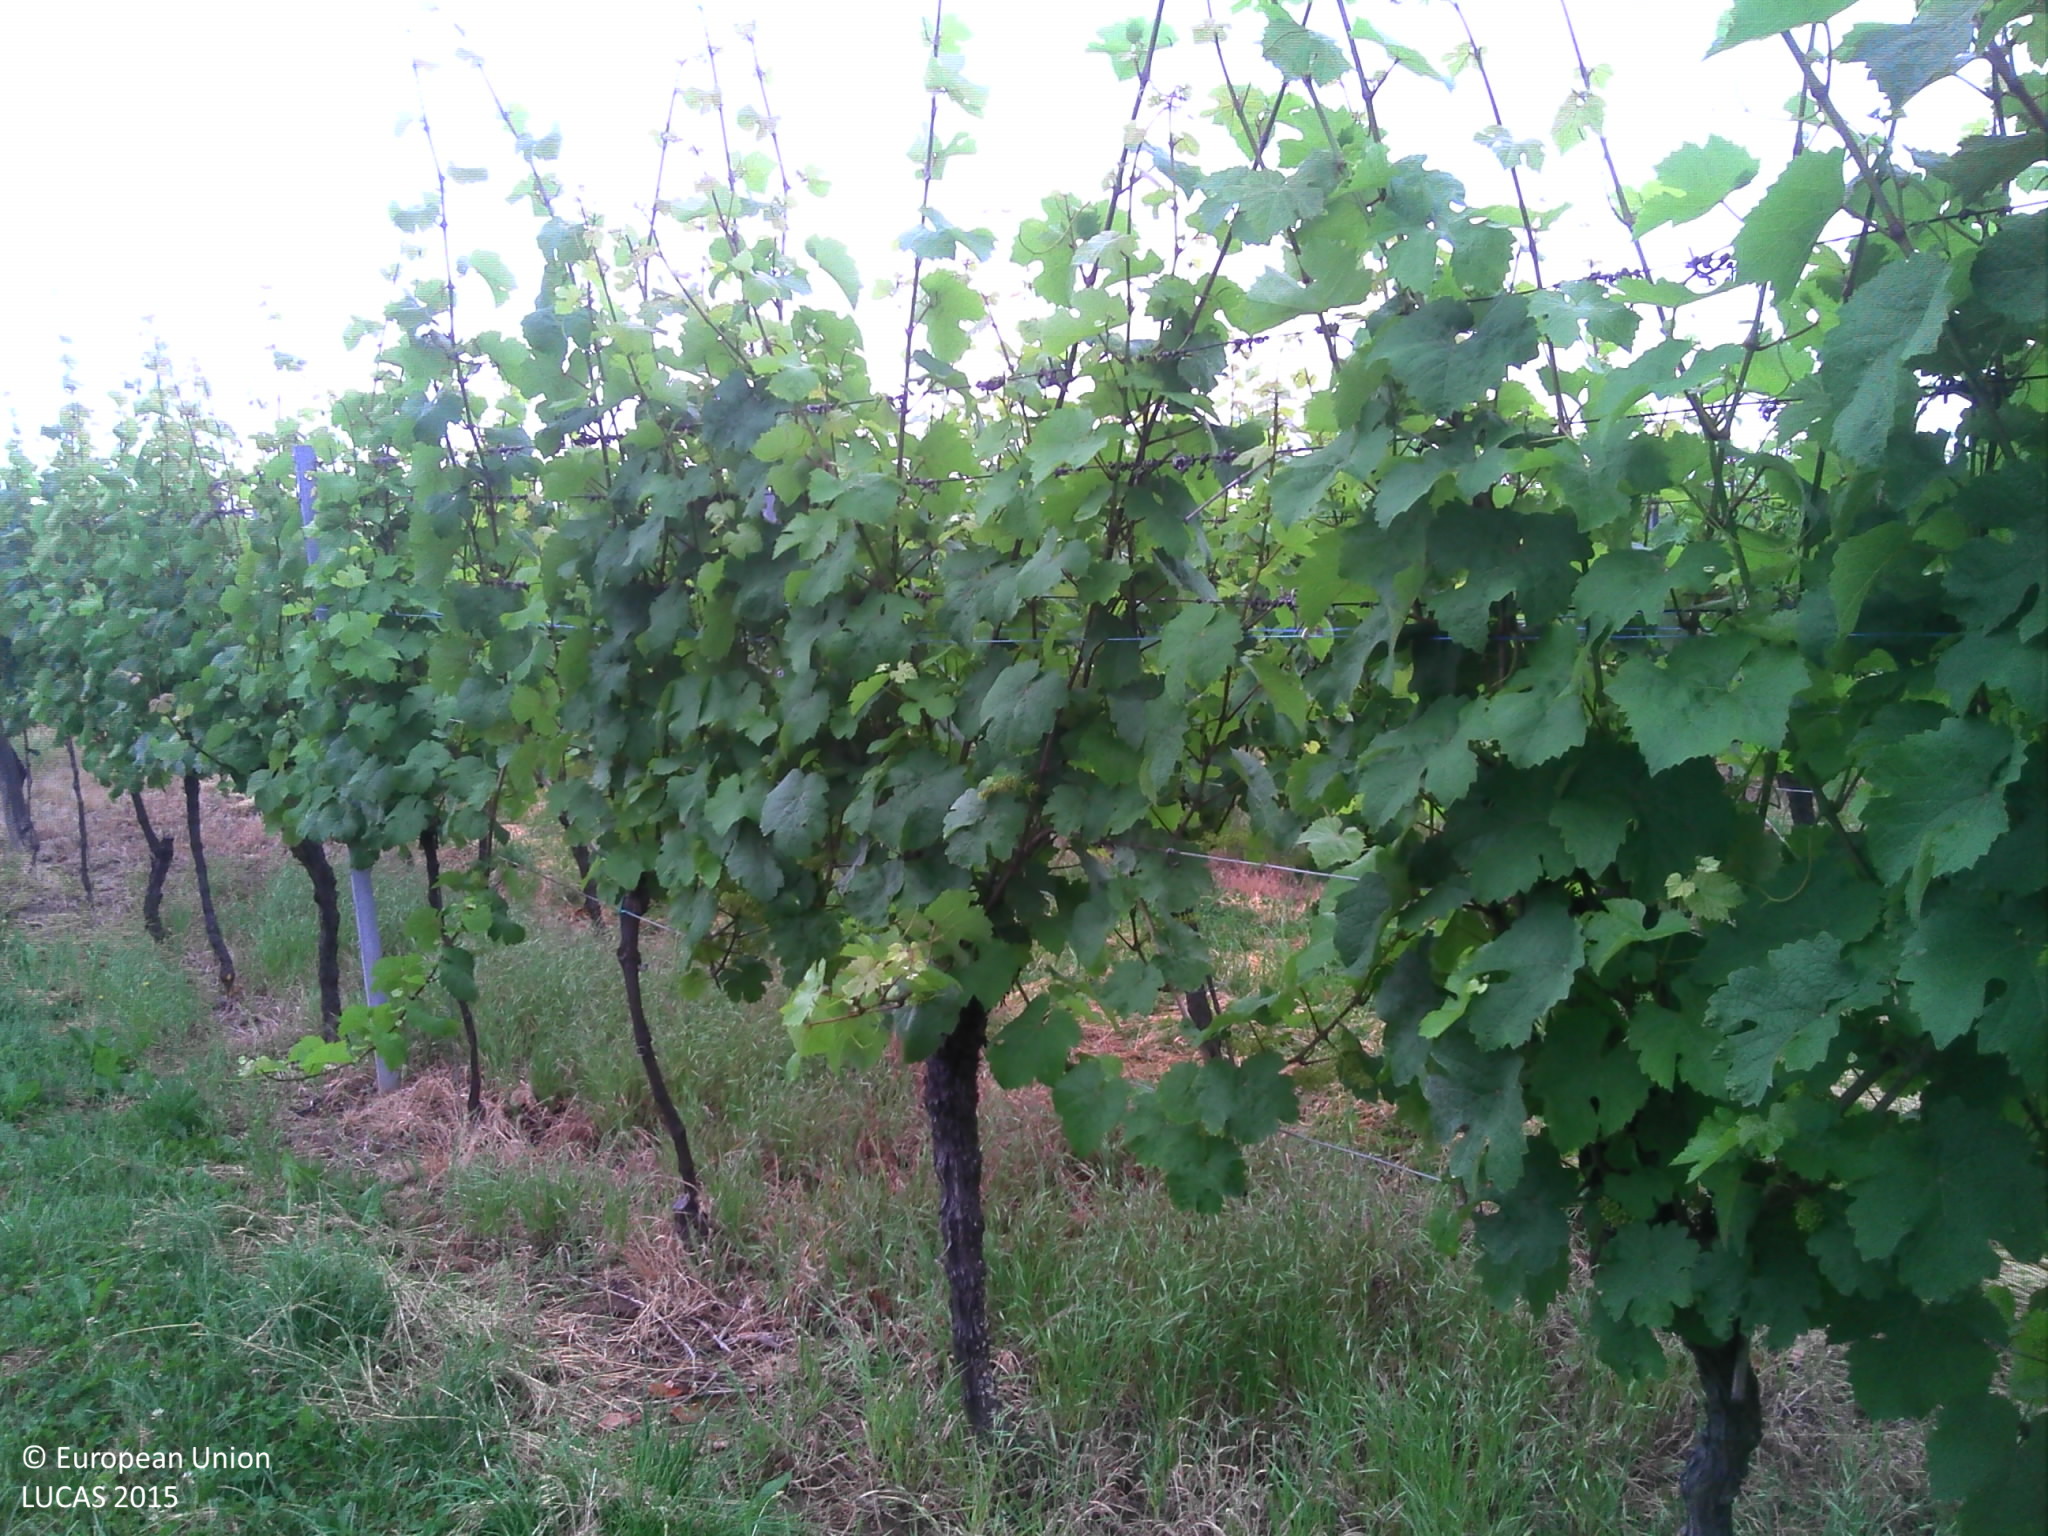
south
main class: Cropland
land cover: Vineyards
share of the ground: 50 - 75 %
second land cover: Grassland without tree/shrub cover
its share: 50 - 75 %
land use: Agriculture (excluding fallow land and kitchen gardens)
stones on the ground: < 10 %
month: June
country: FR
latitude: 48.3927
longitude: 7.4754
